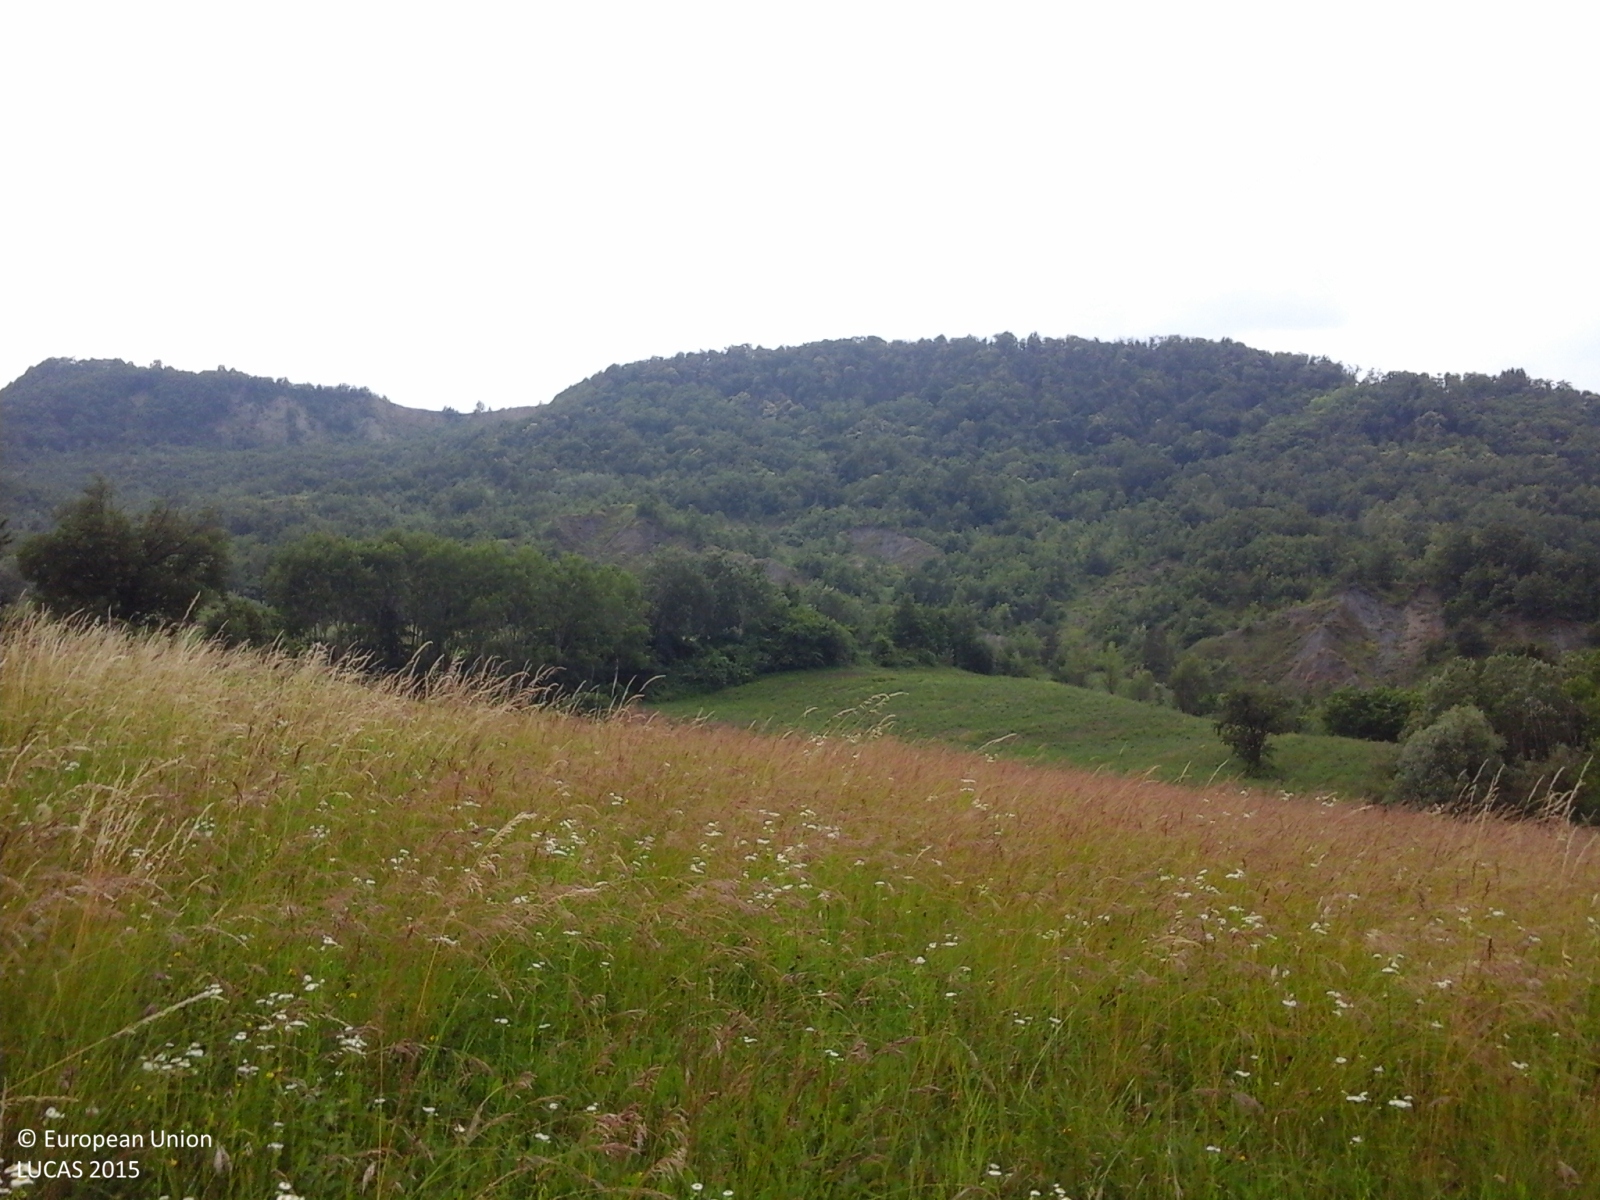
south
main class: Grassland
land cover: Grassland without tree/shrub cover
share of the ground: > 75 %
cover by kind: herbaceous plants 100 %
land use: Agriculture (excluding fallow land and kitchen gardens)
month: June
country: IT
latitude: 44.8188
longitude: 9.6340
